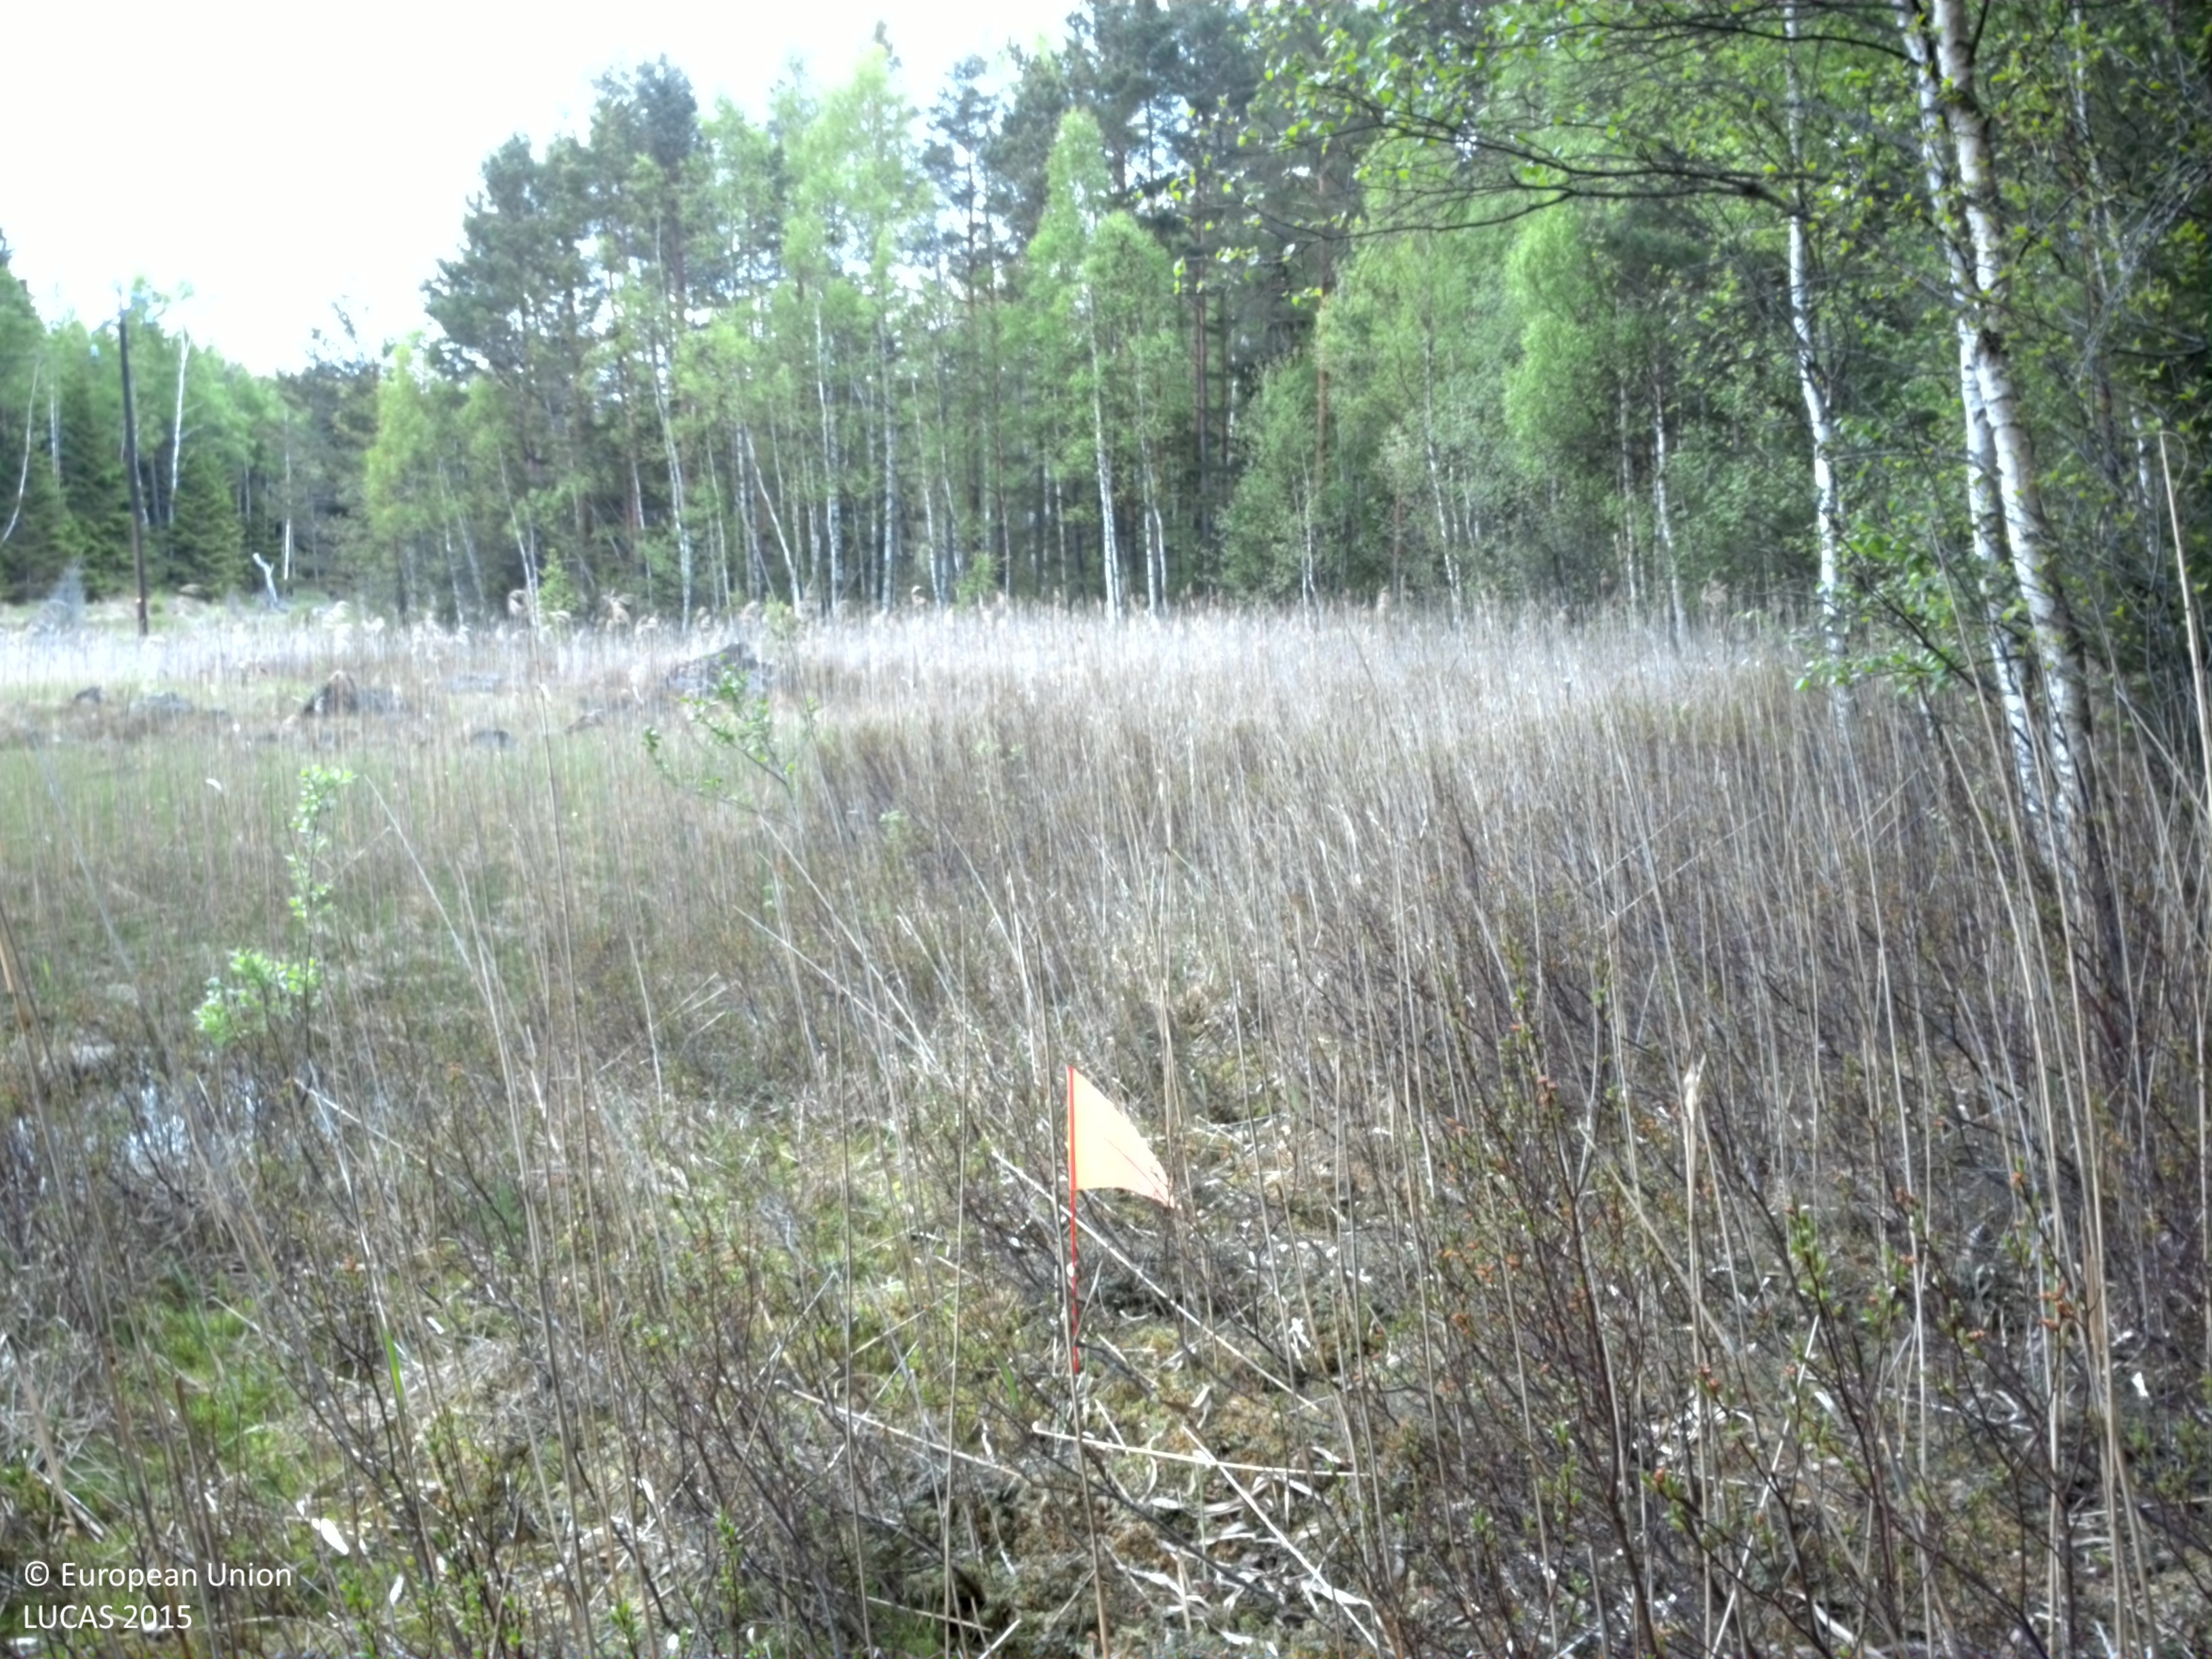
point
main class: Shrubland
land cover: Shrubland with sparse tree cover
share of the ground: 25 - 50 %
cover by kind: lichens and mosses 60 %, shrubs 25 %, herbaceous plants 10 %, broadleaved forest trees 5 %
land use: Semi-natural and natural areas not in use
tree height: < 5 m
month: May
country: SE
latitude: 57.4215
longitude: 15.5086
